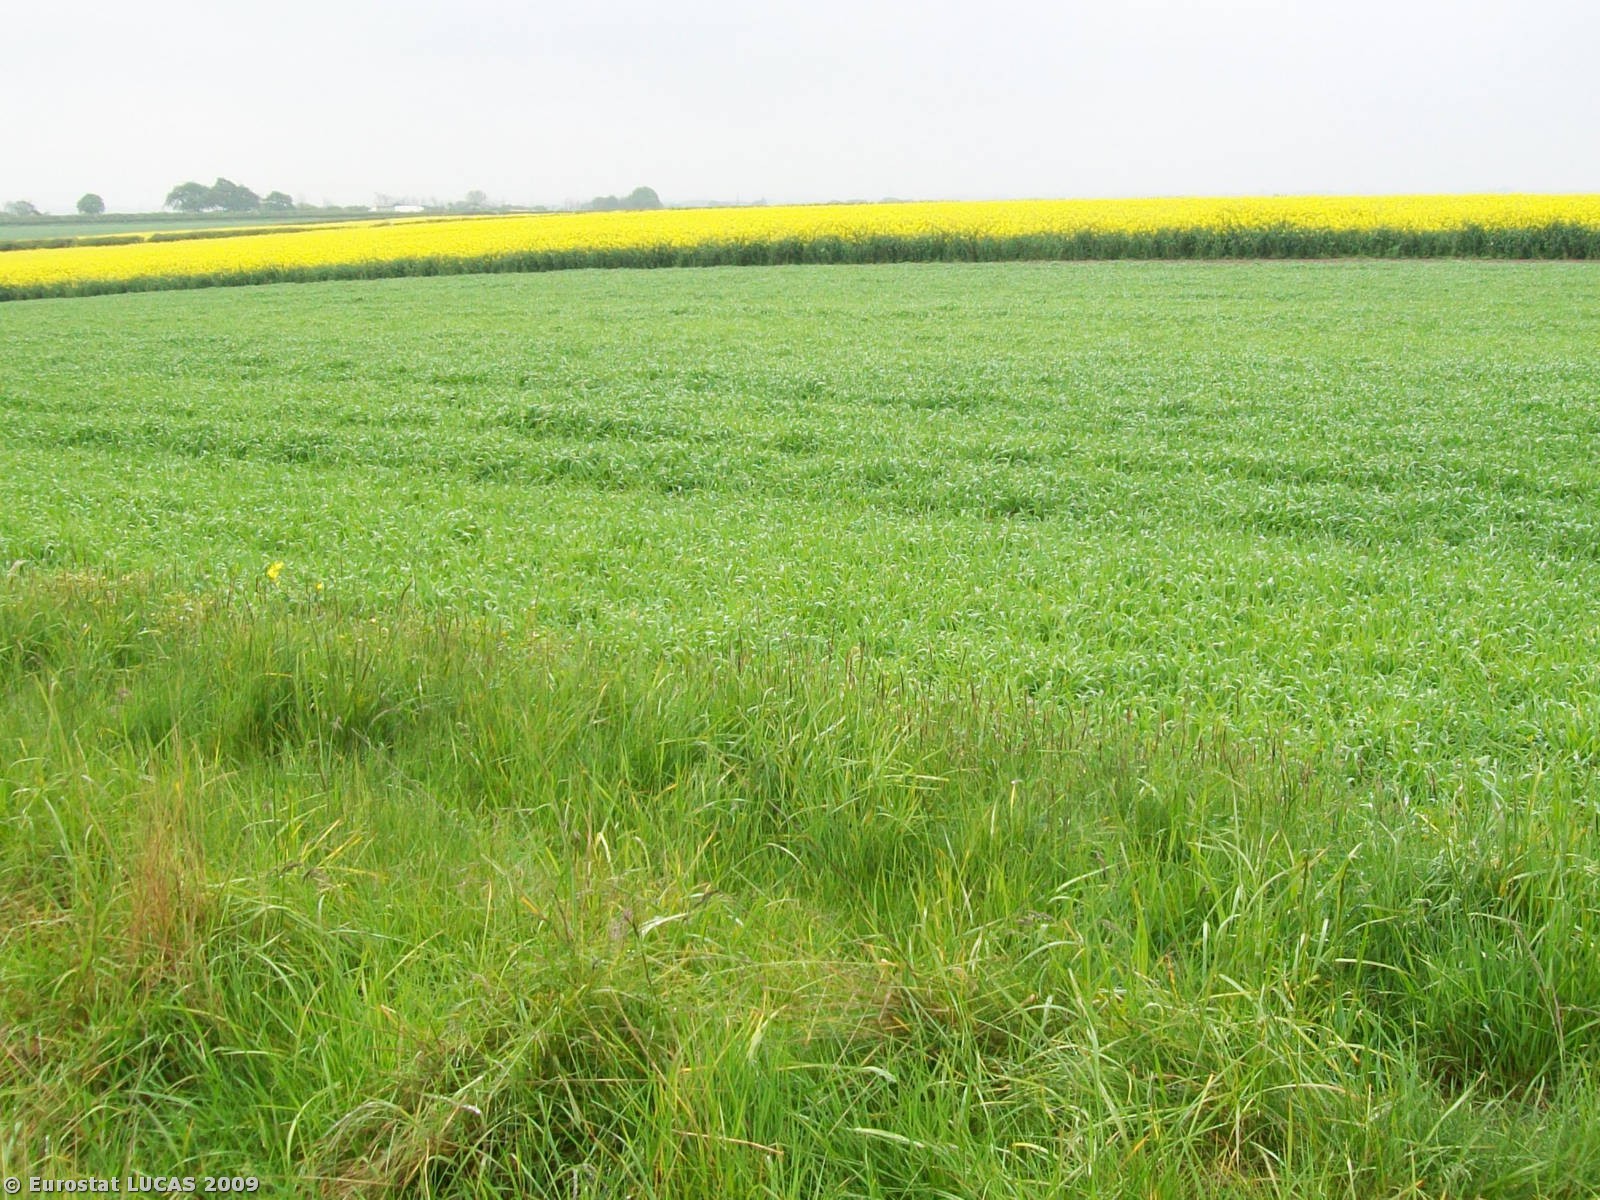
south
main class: Grassland
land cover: Grassland with sparse tree/shrub cover
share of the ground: 25 - 50 %
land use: Agriculture (excluding fallow land and kitchen gardens)
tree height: > 5 m
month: May
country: GB
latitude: 52.9631
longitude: -0.8958
